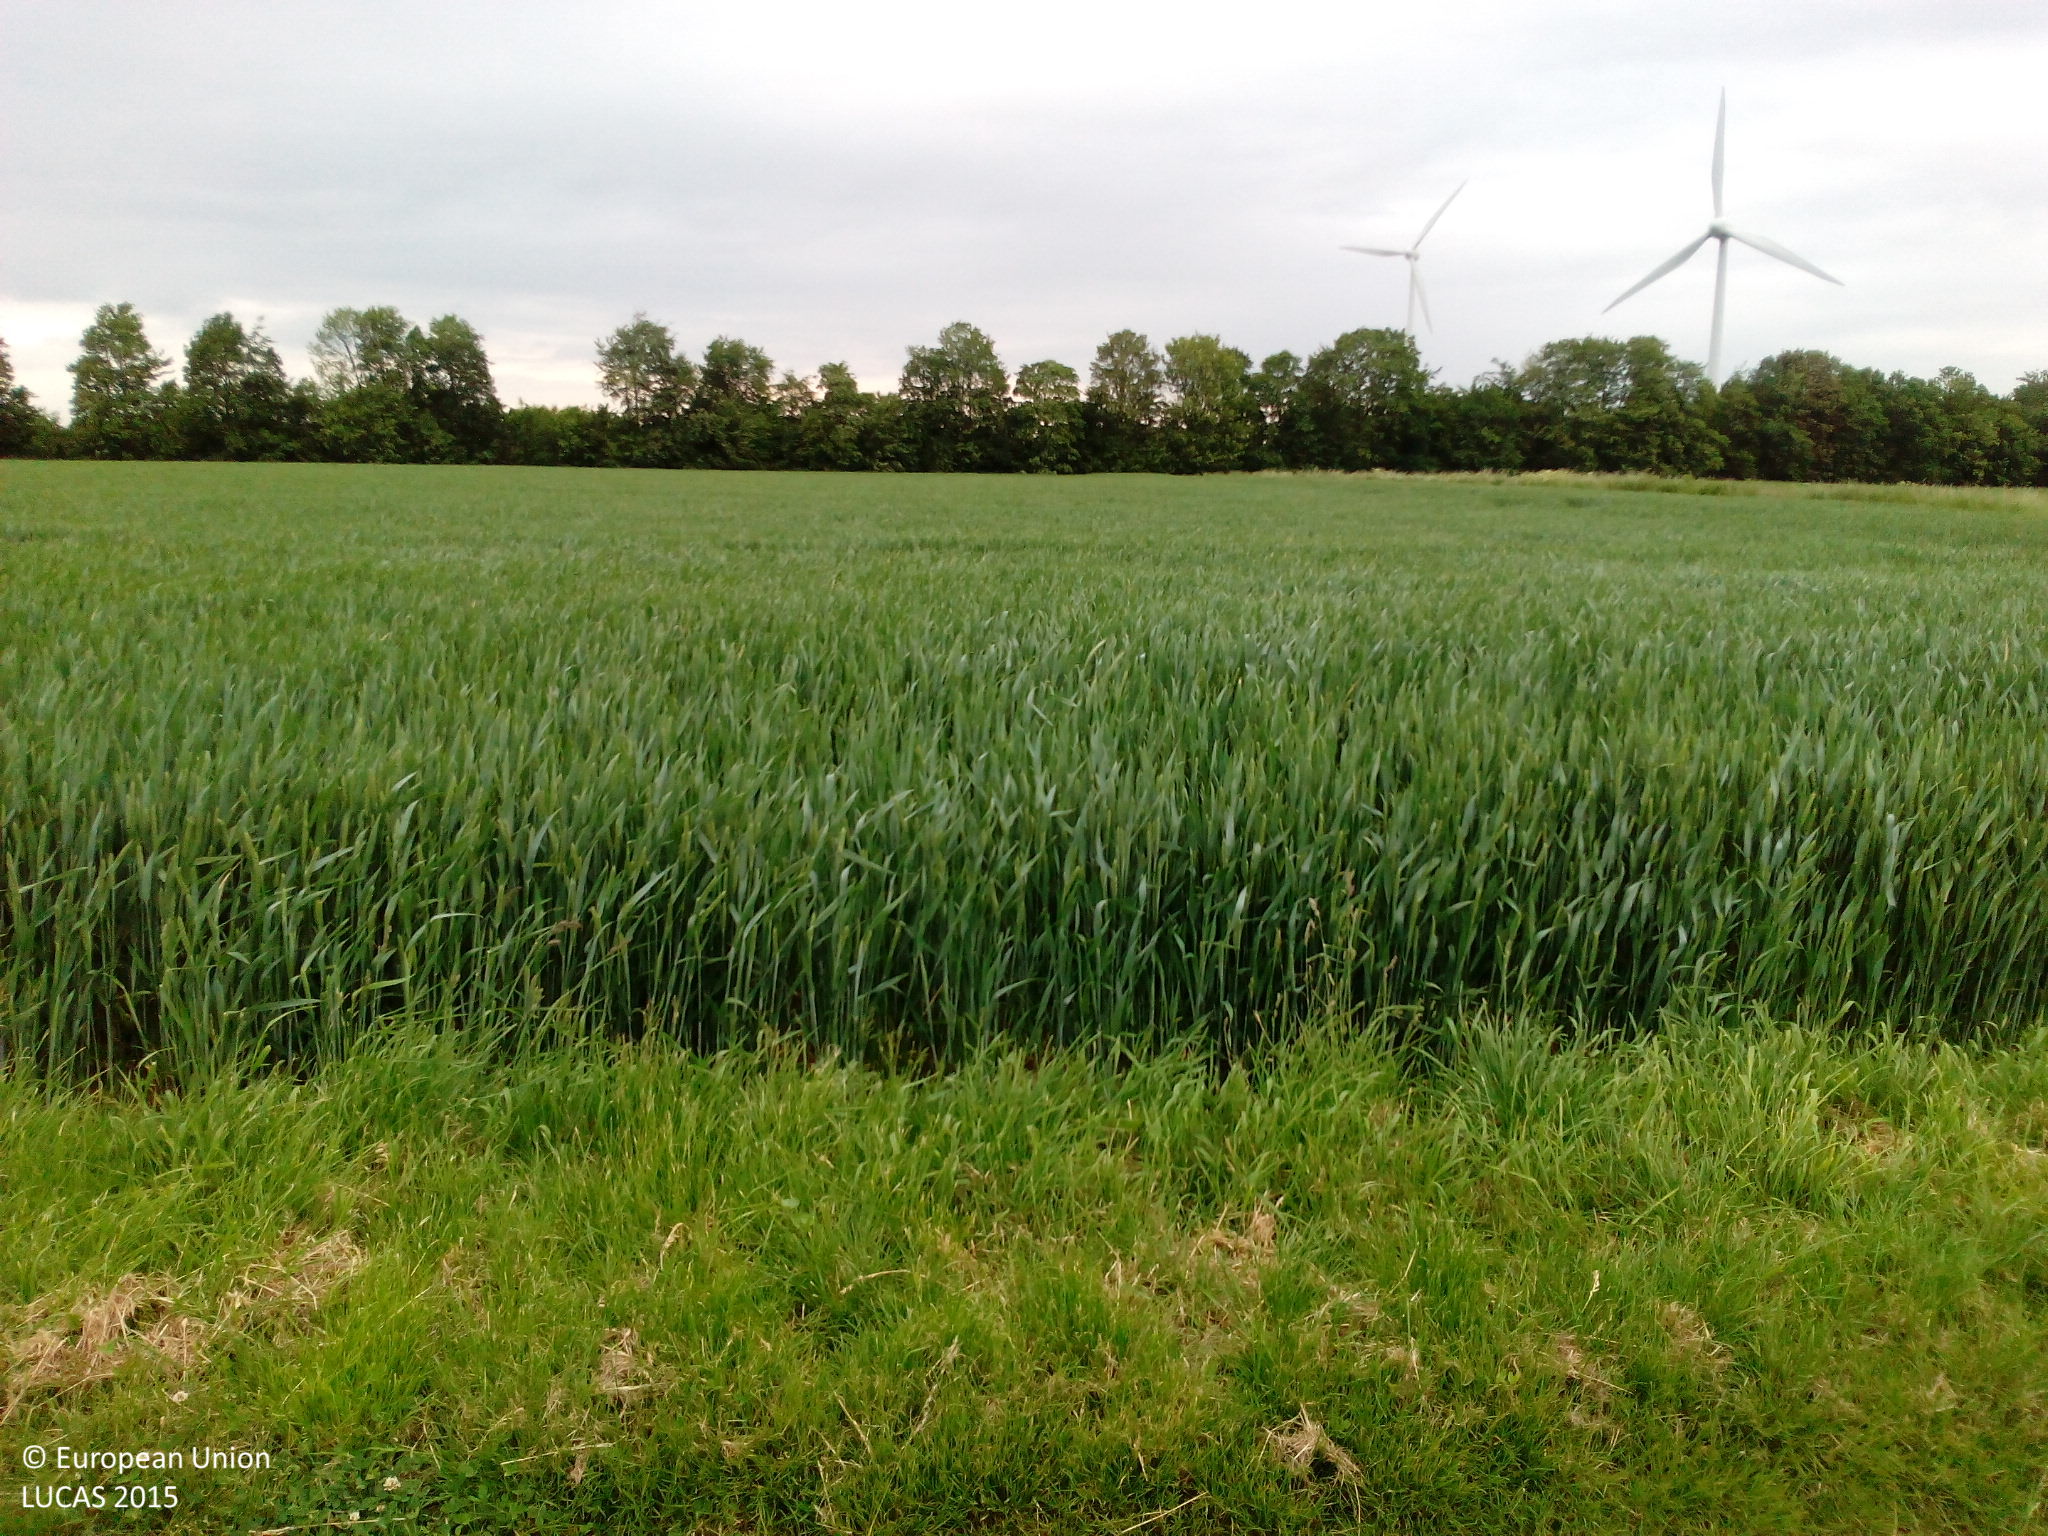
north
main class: Cropland
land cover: Barley
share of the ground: > 75 %
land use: Agriculture (excluding fallow land and kitchen gardens)
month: June
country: DE
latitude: 51.5330
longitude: 7.9677
